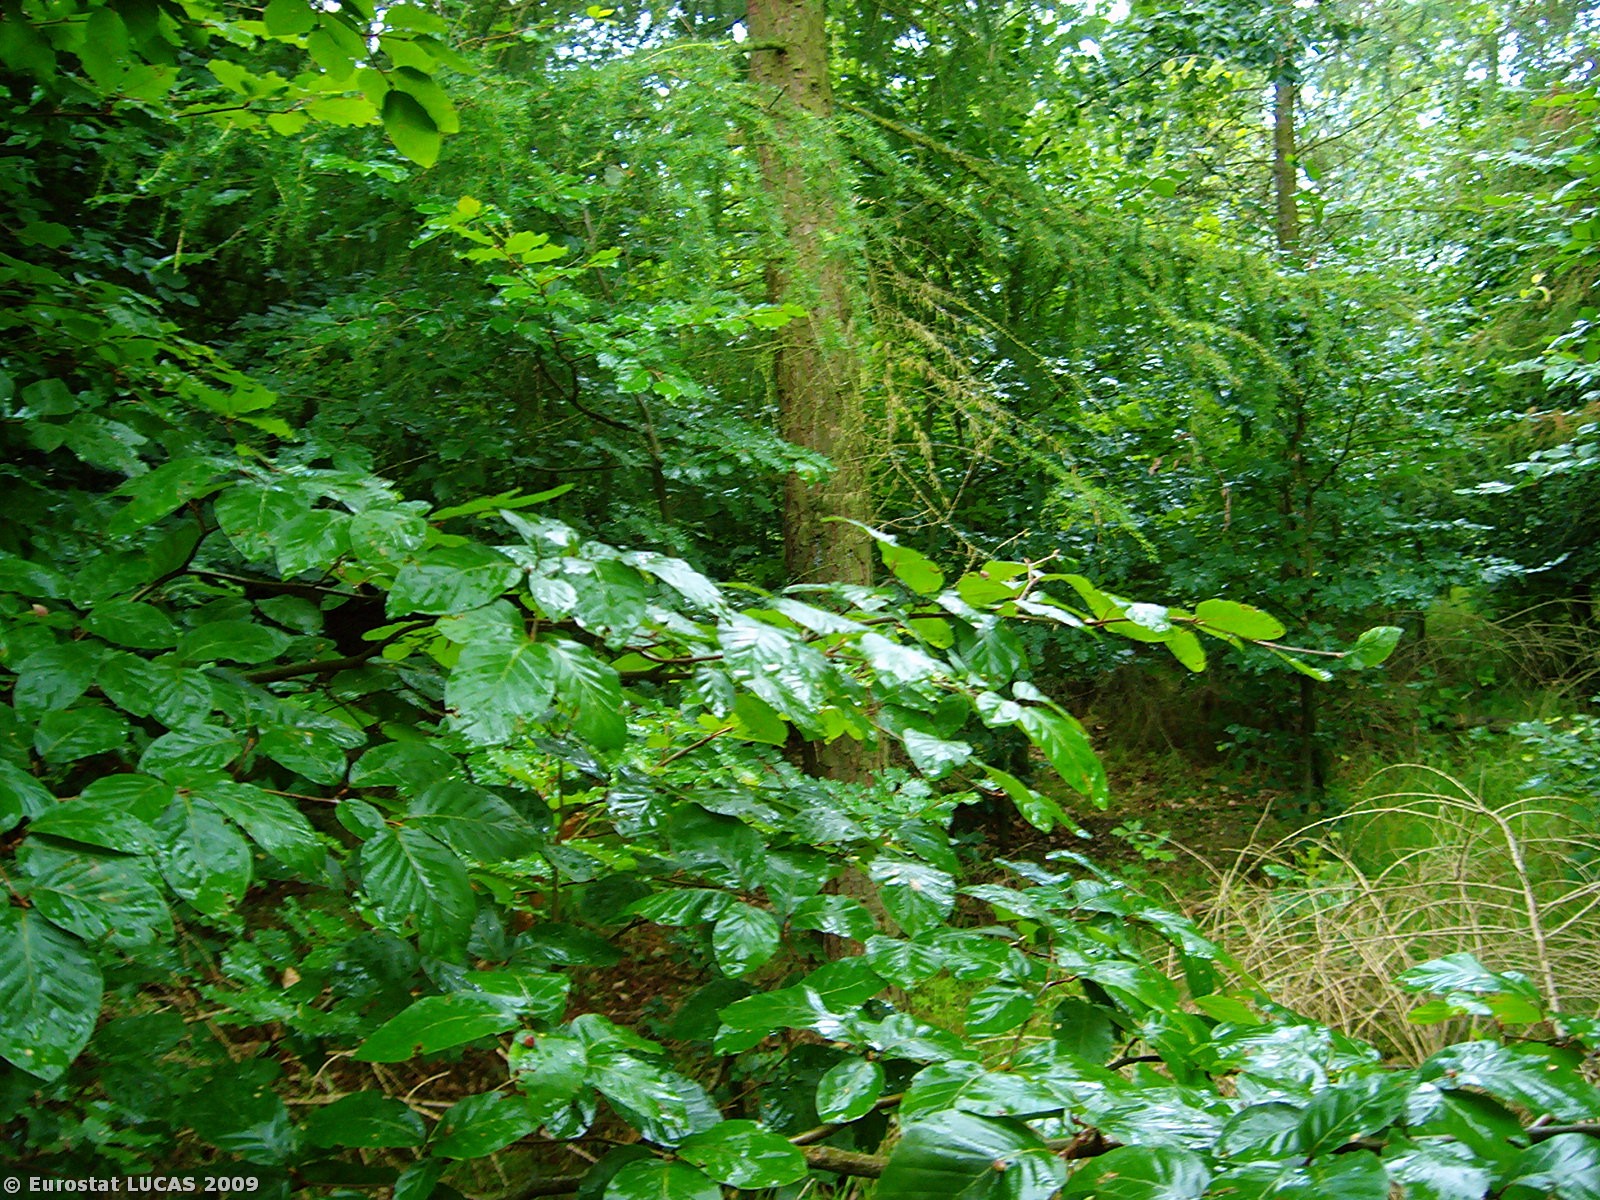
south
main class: Woodland
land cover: Mixed woodland
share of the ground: > 75 %
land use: Unused
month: July
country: PL
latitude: 52.3093
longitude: 15.3866
